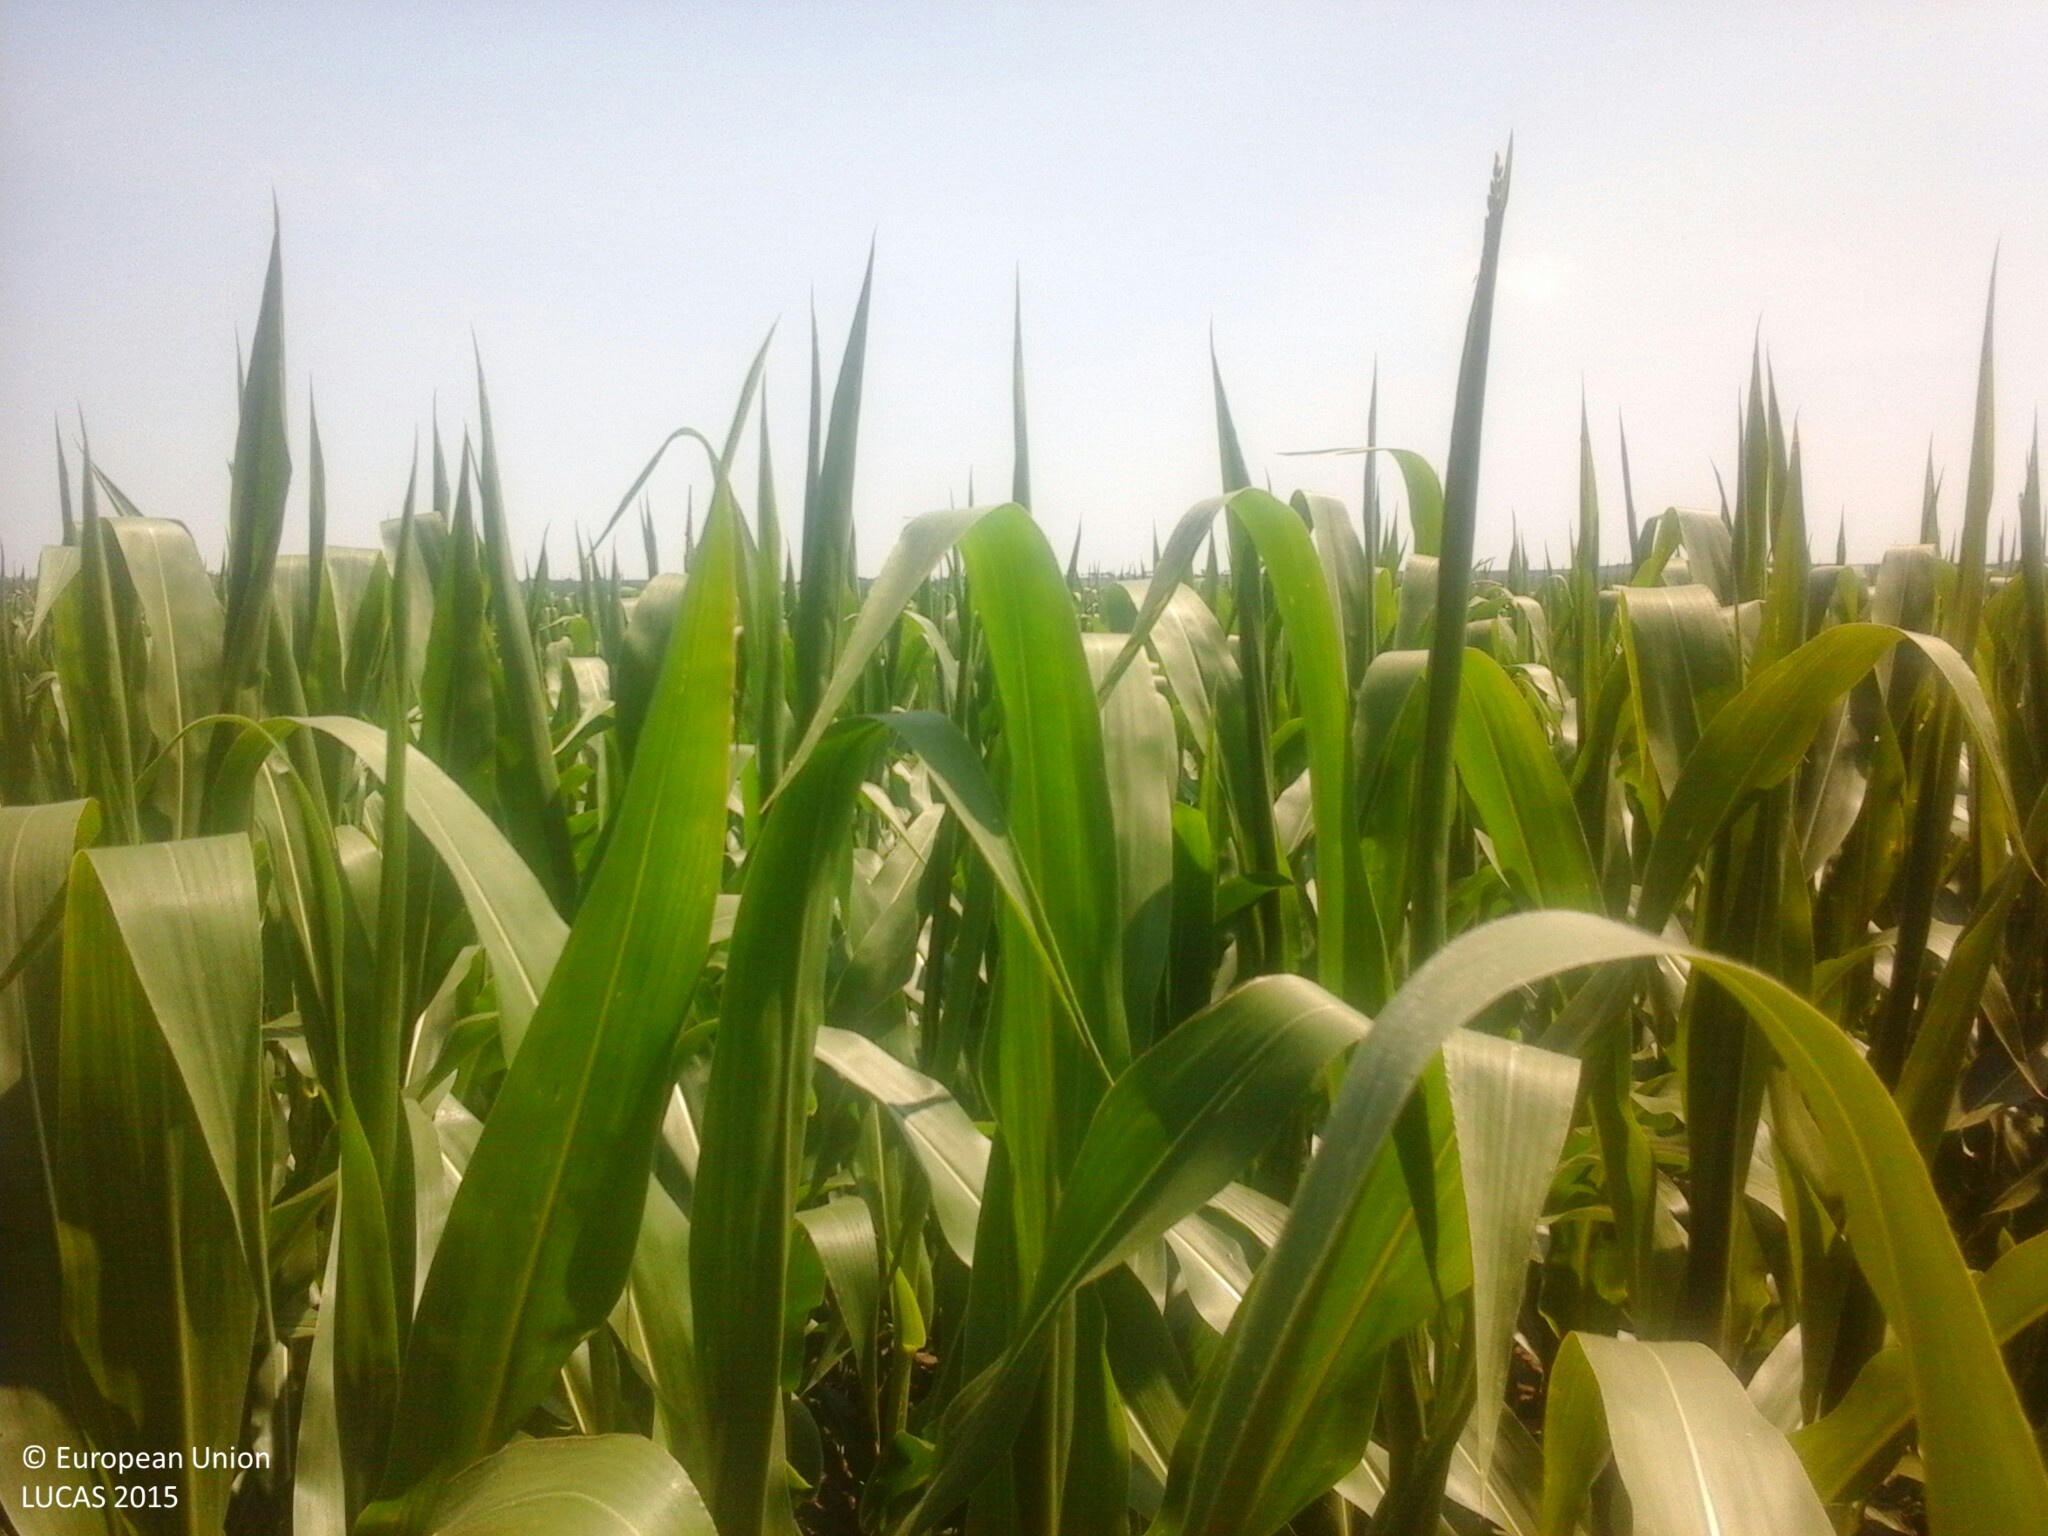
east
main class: Cropland
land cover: Maize
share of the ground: > 75 %
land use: Agriculture (excluding fallow land and kitchen gardens)
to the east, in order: Maize
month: July
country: HU
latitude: 47.4729
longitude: 18.5724
